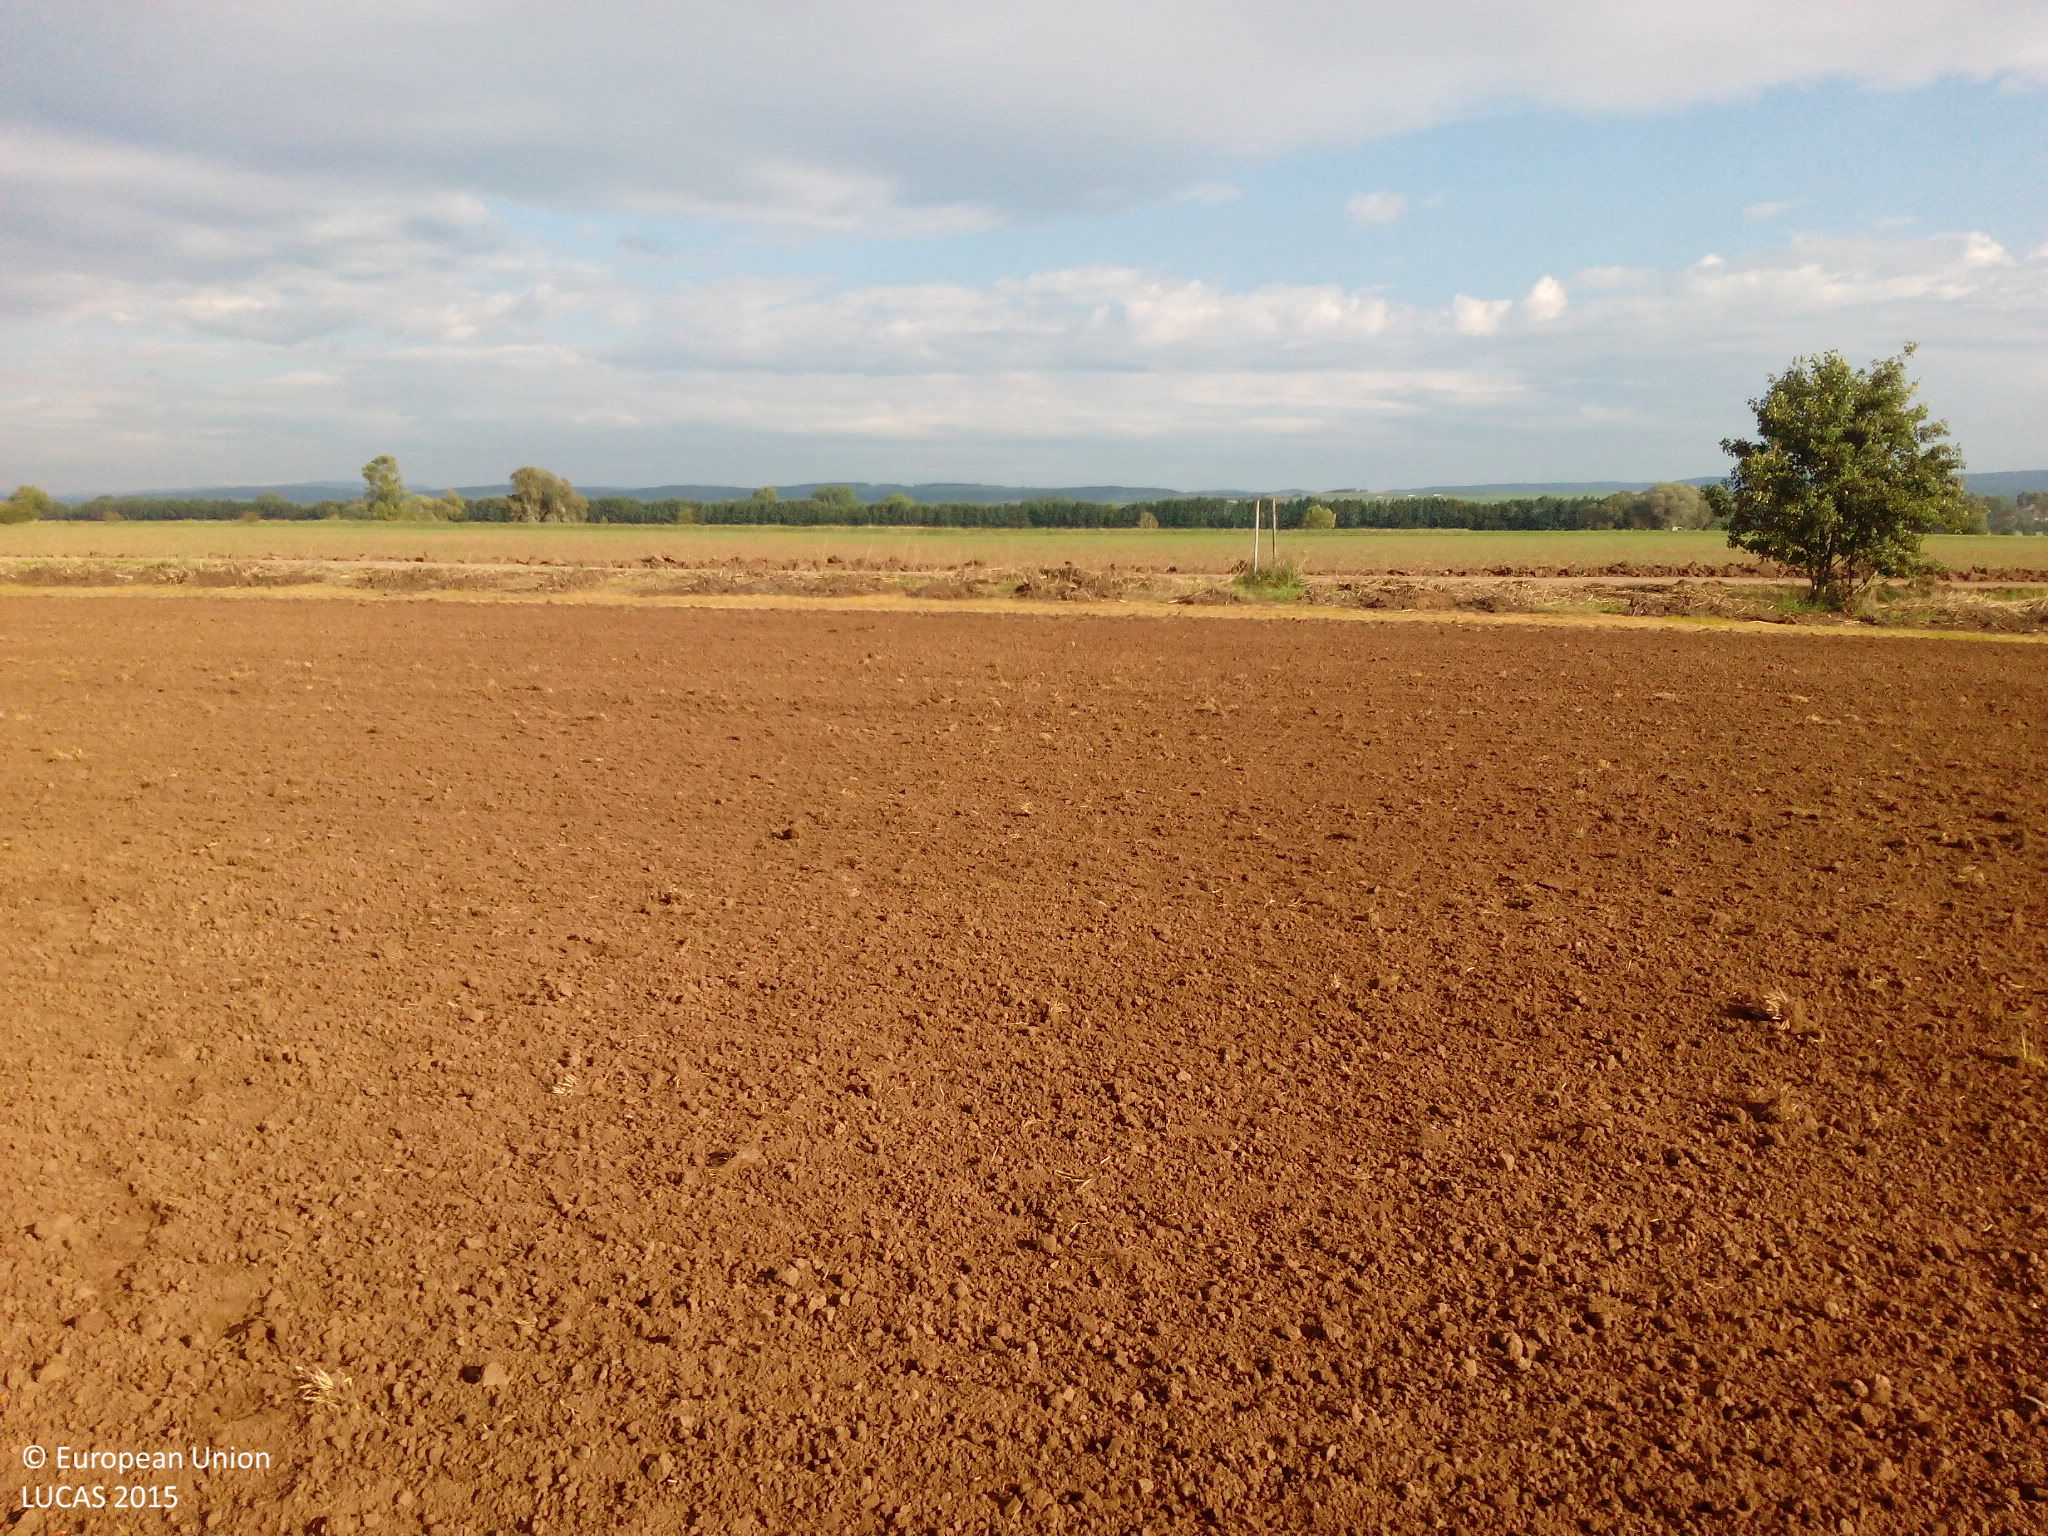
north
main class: Cropland
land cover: Barley
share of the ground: < 10 %
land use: Agriculture (excluding fallow land and kitchen gardens)
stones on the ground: < 10 %
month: September
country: DE
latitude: 51.4388
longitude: 10.9636
